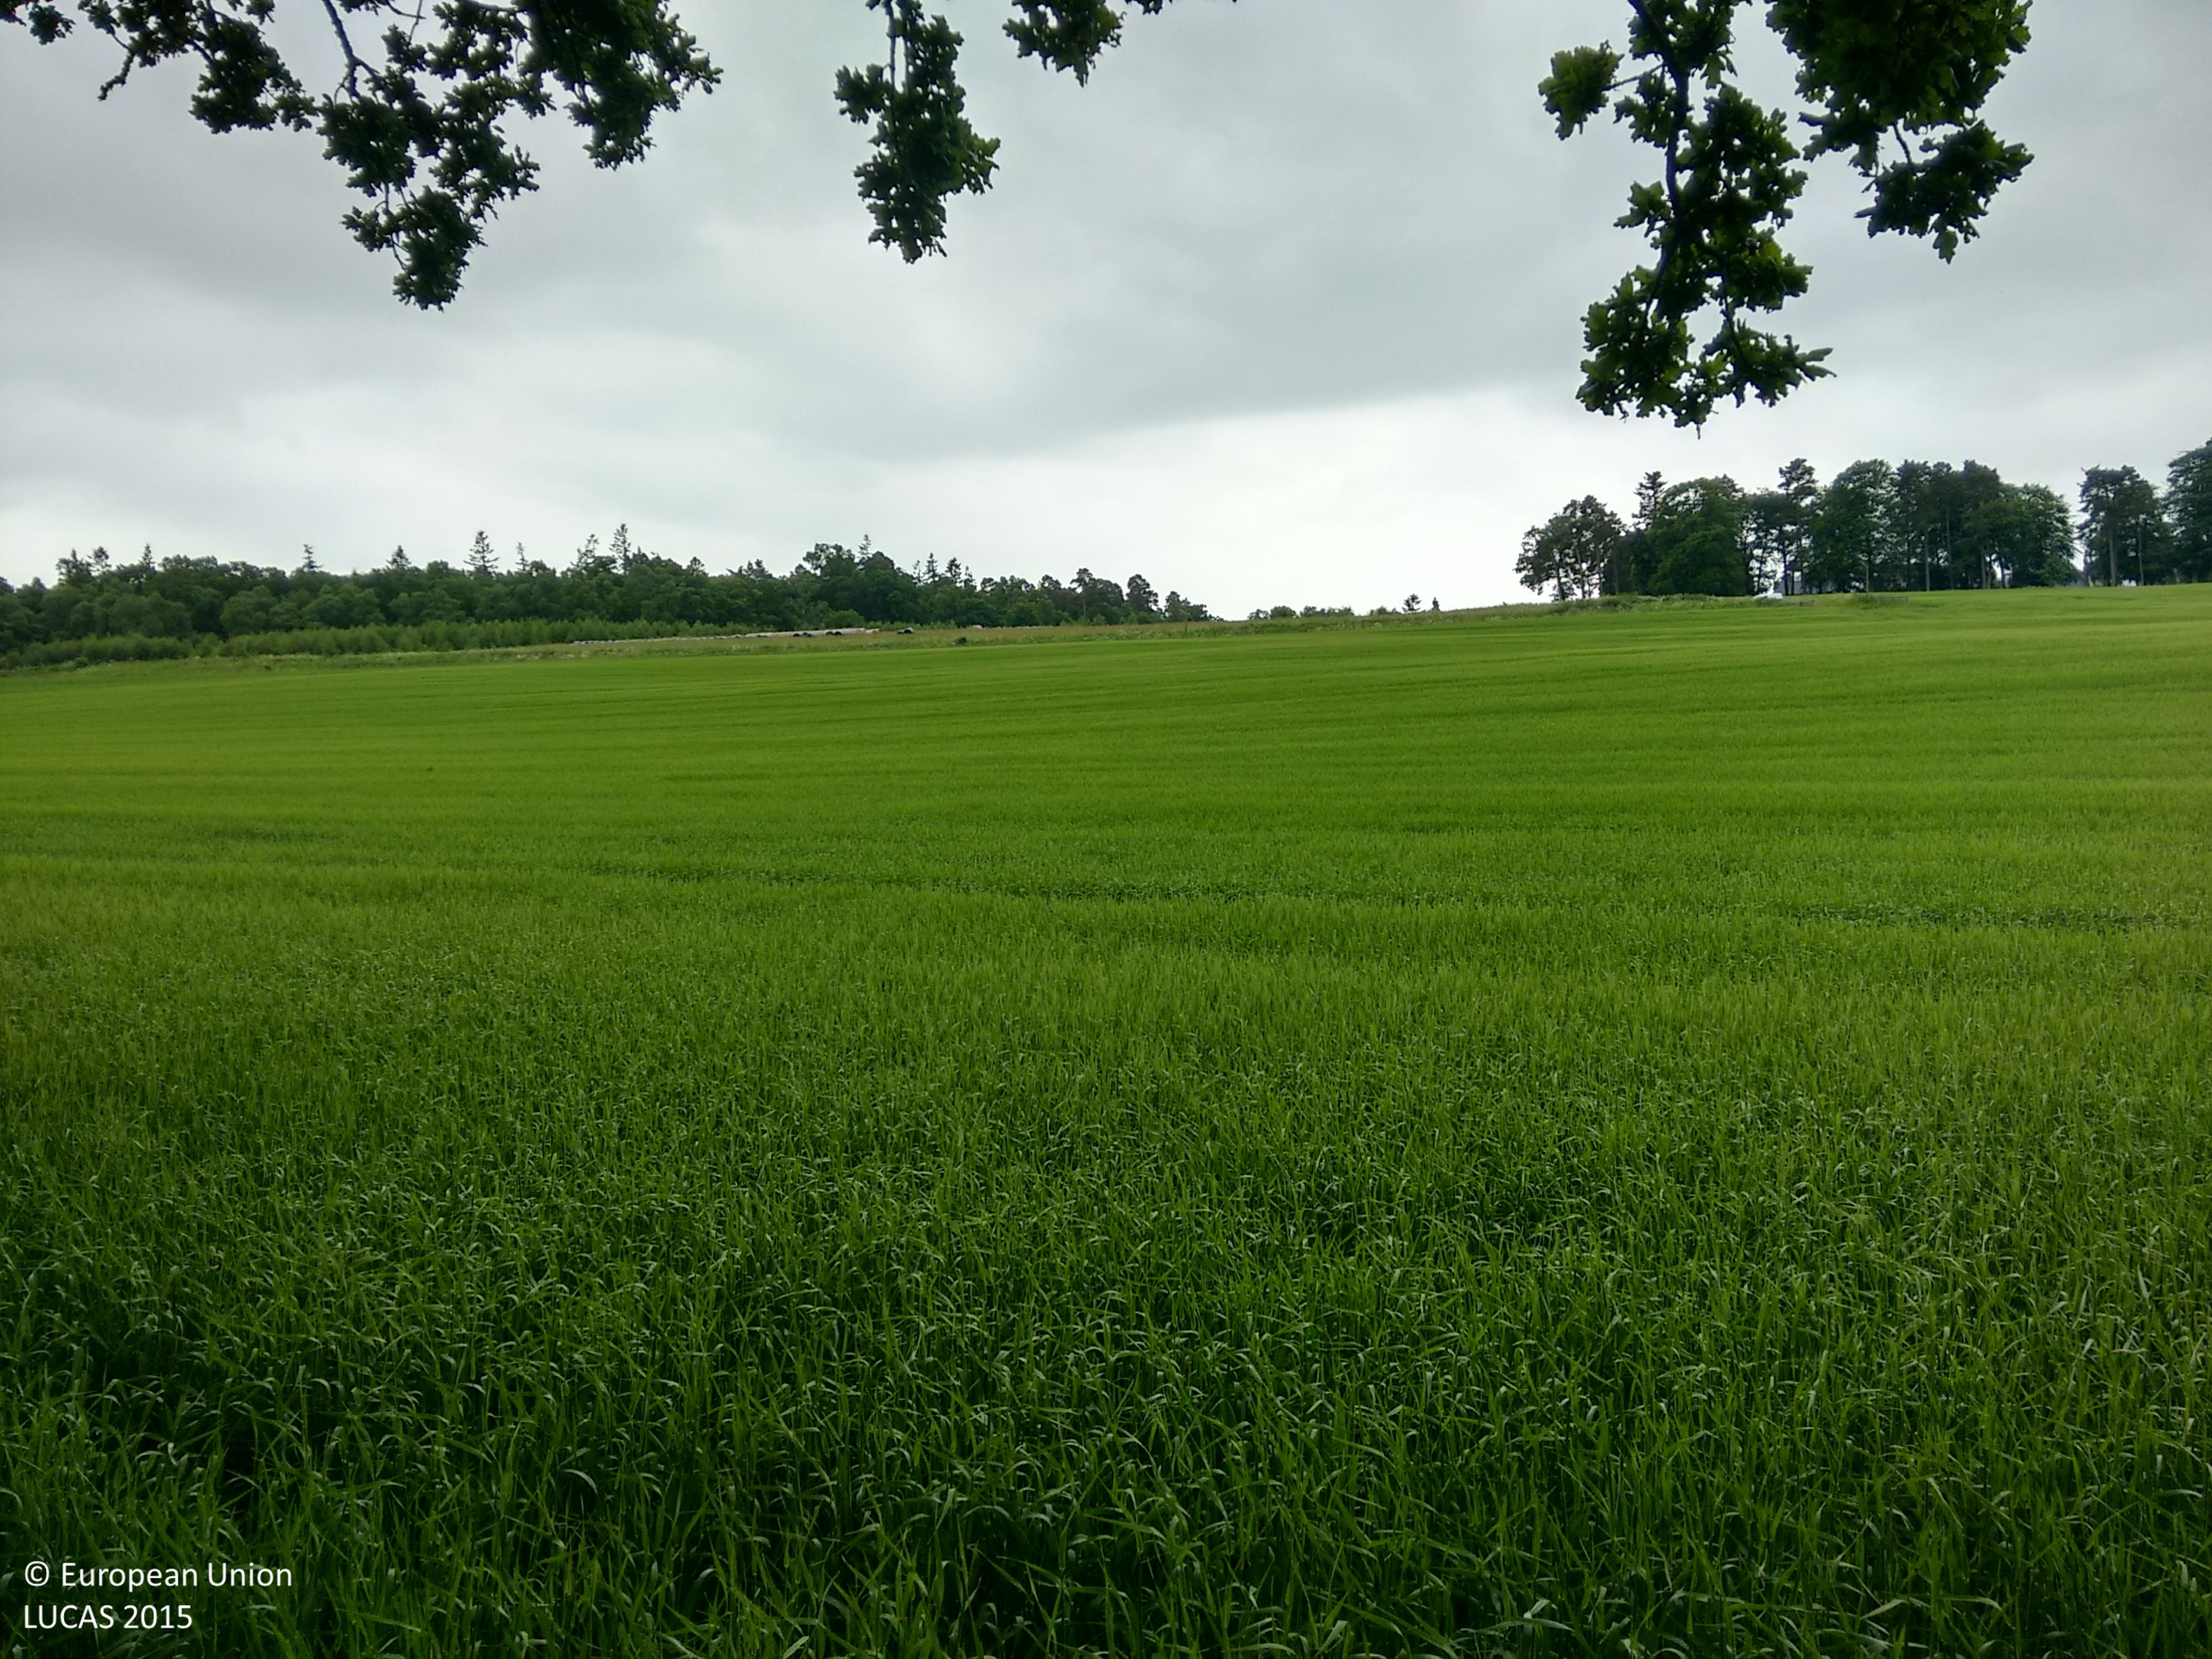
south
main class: Woodland
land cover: Broadleaved woodland
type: mesophytic deciduous forest
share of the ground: > 75 %
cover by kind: broadleaved forest trees 100 %
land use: Agriculture (excluding fallow land and kitchen gardens)
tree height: > 5 m
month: June
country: GB
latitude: 56.5338
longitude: -3.4559
